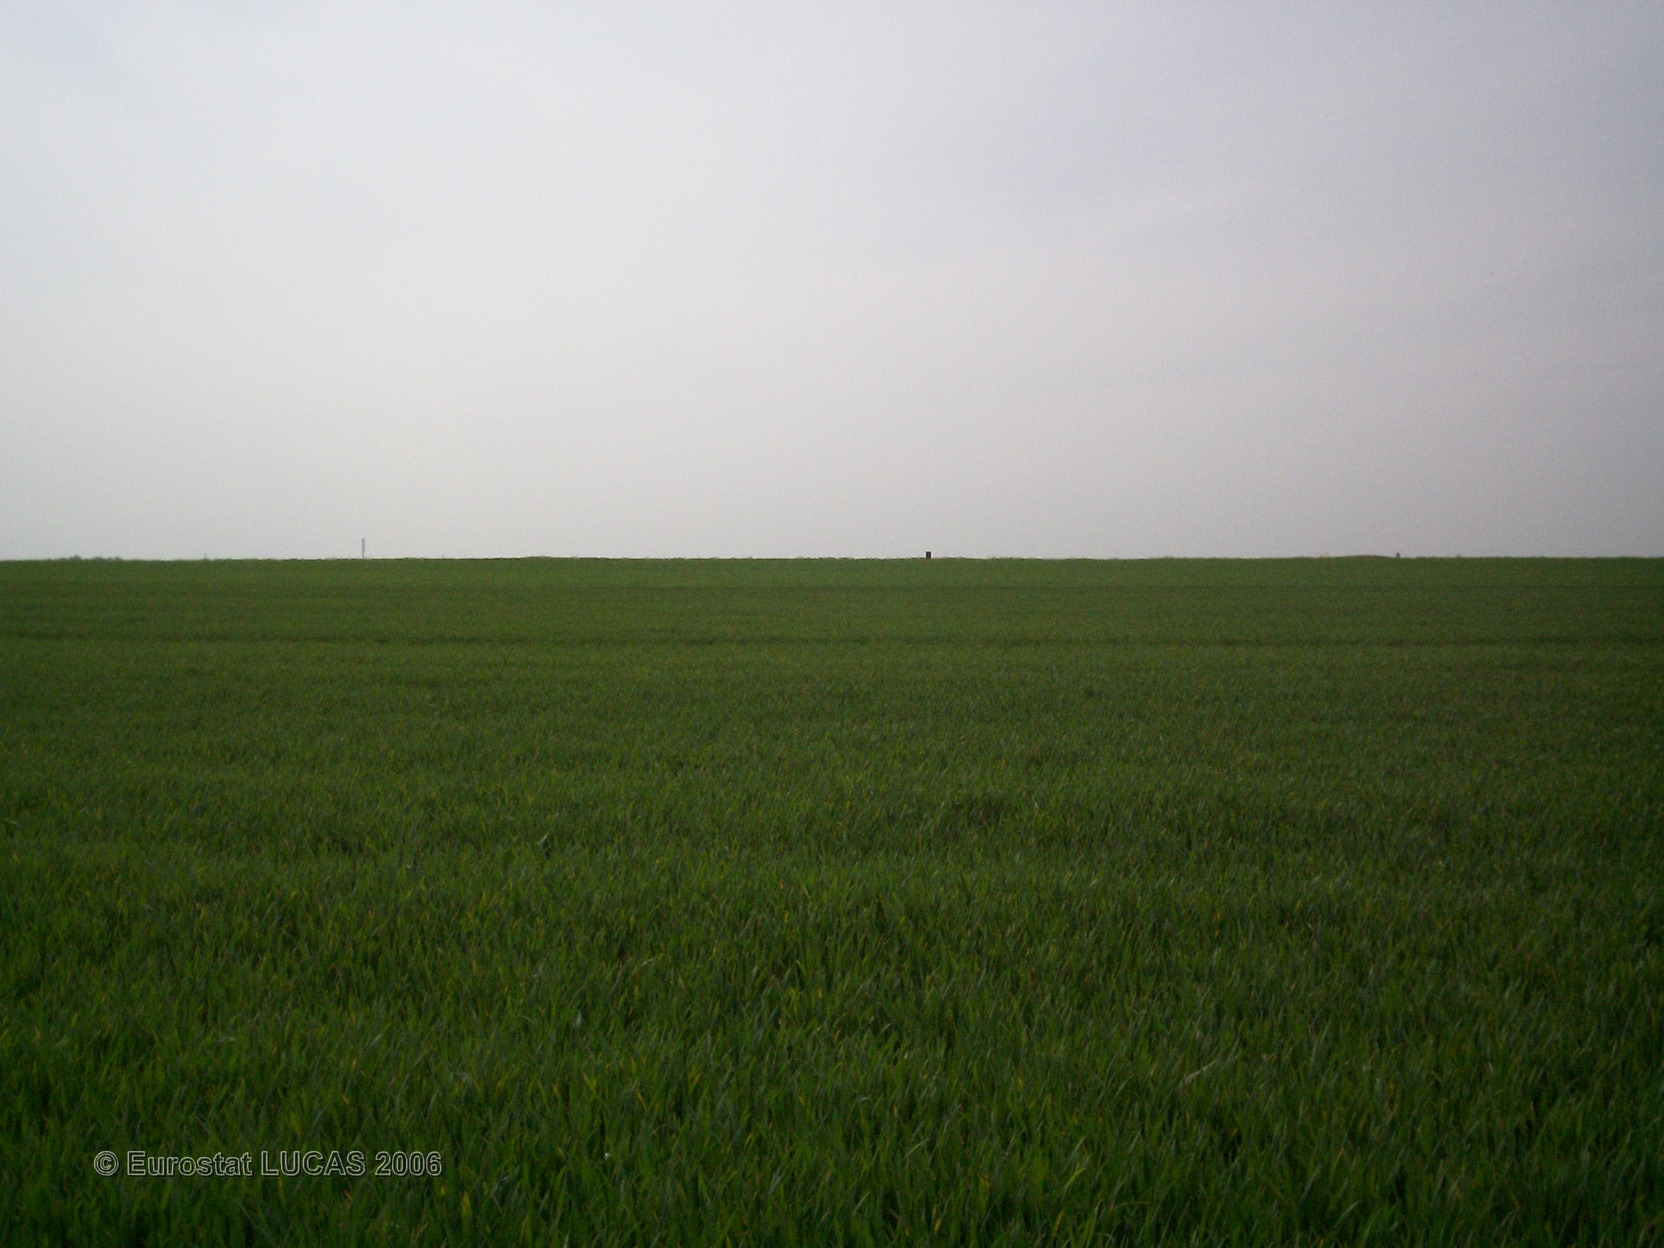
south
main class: Cropland
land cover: Common wheat
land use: Agriculture (excluding fallow land and kitchen gardens)
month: May
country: FR
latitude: 48.6229
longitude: 2.8413
